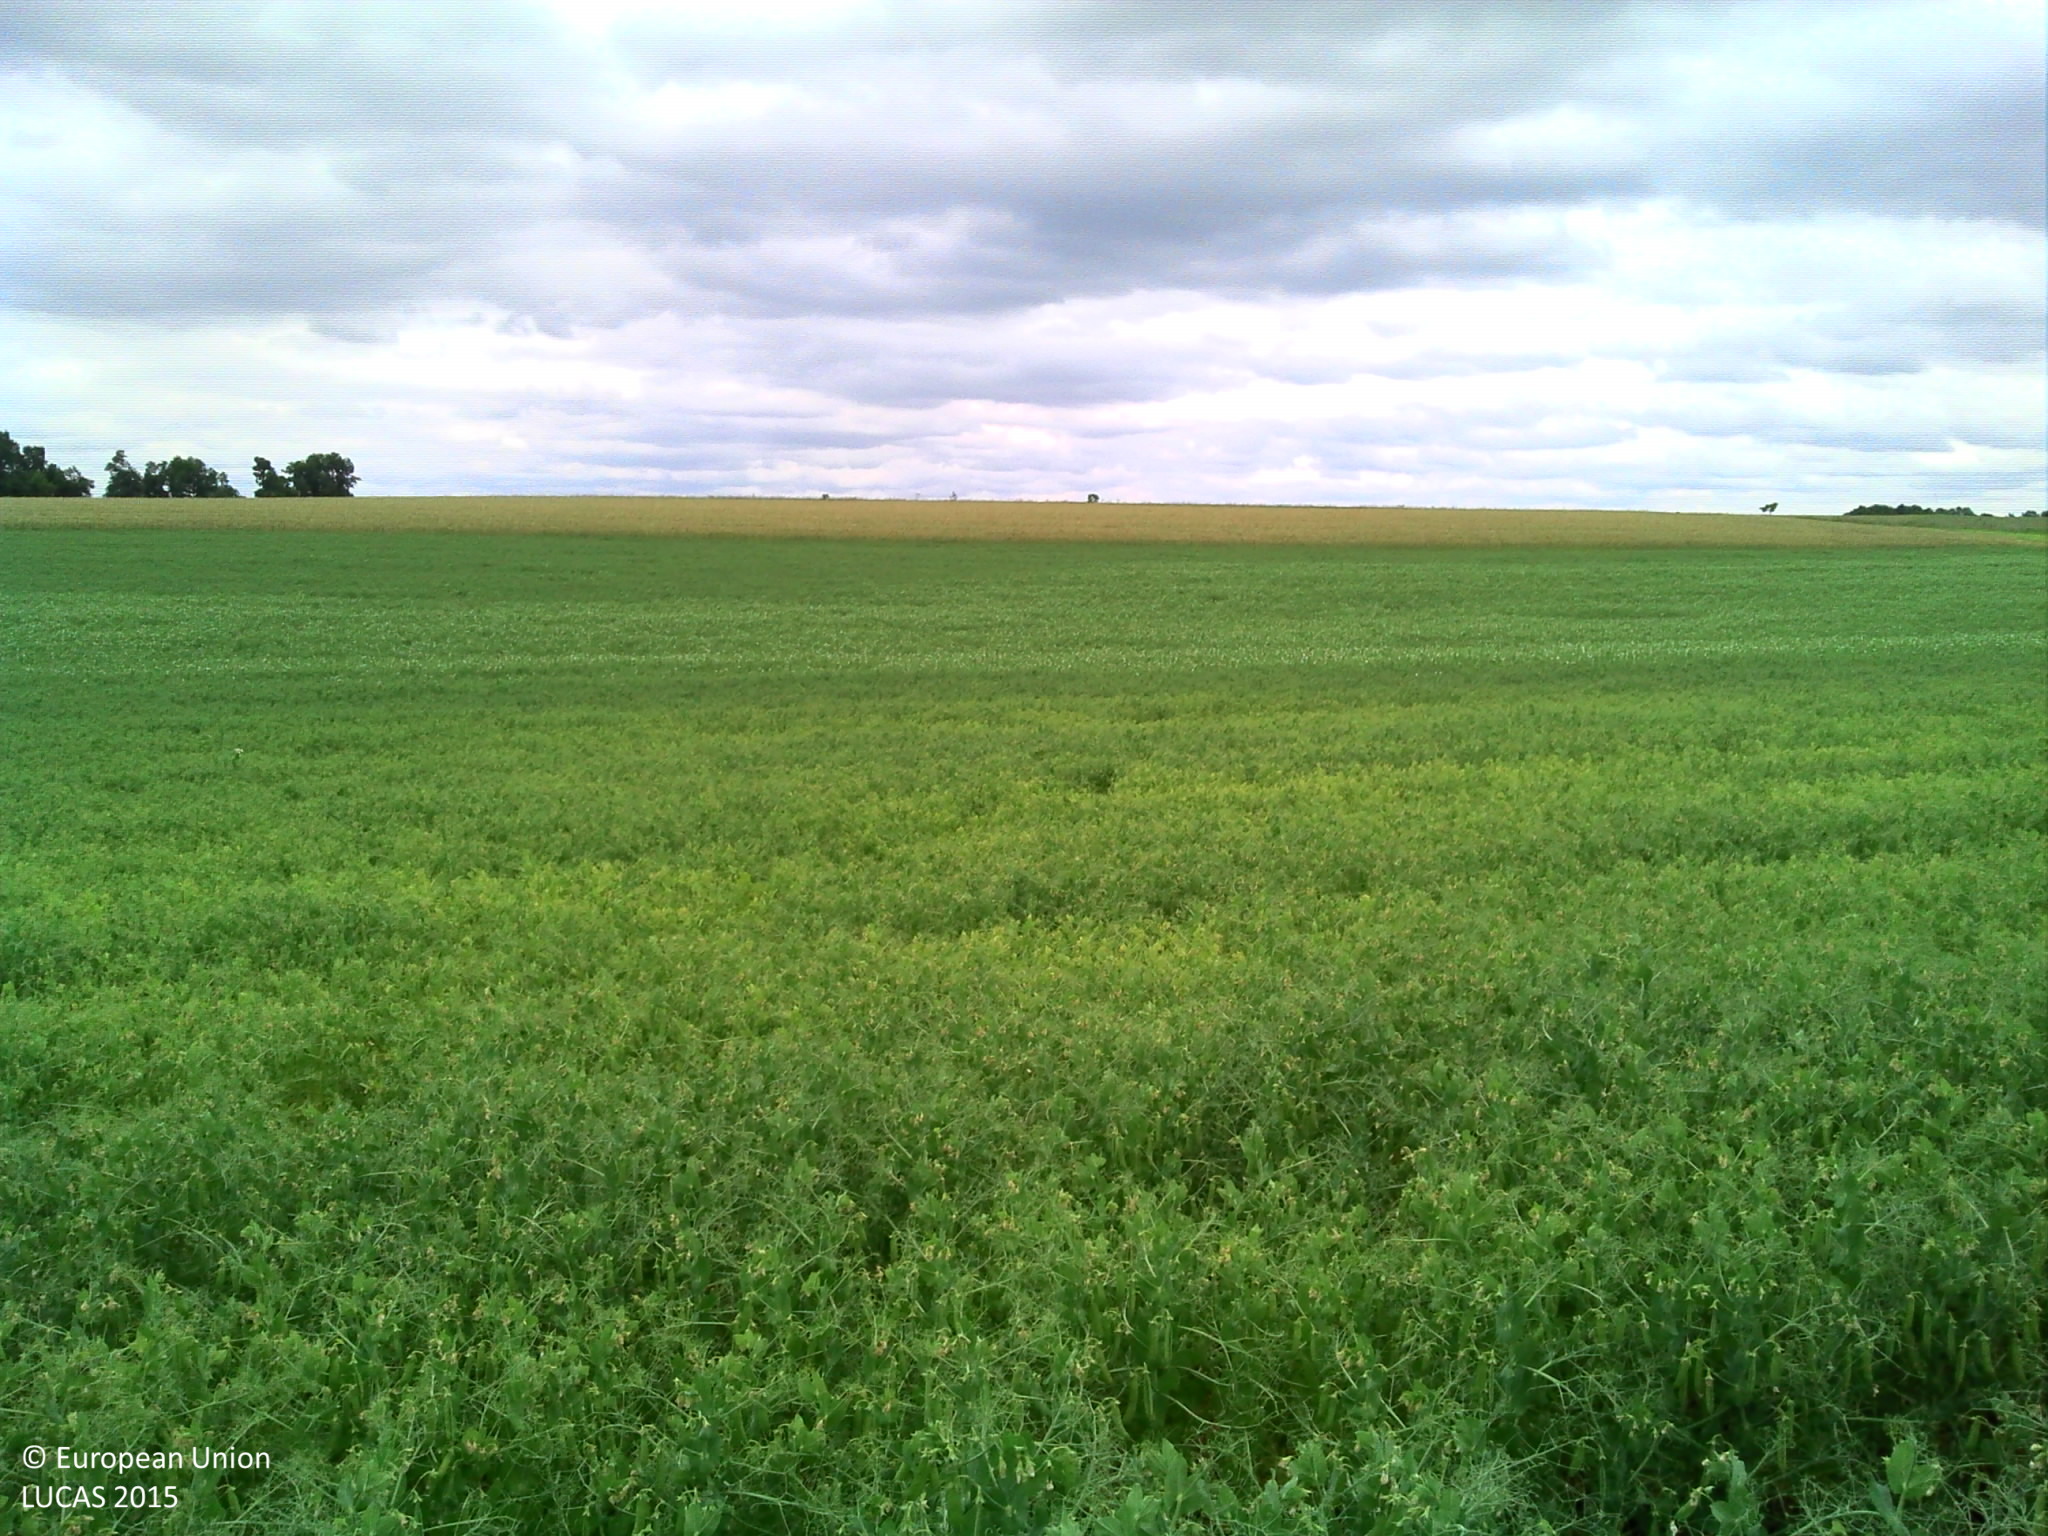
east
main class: Cropland
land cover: Dry pulses
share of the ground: > 75 %
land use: Agriculture (excluding fallow land and kitchen gardens)
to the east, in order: Dry pulses; Triticale; Lines of trees; Grass margins; Paved roads, cycling and walking lanes
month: June
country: FR
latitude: 46.0368
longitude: 0.3052
